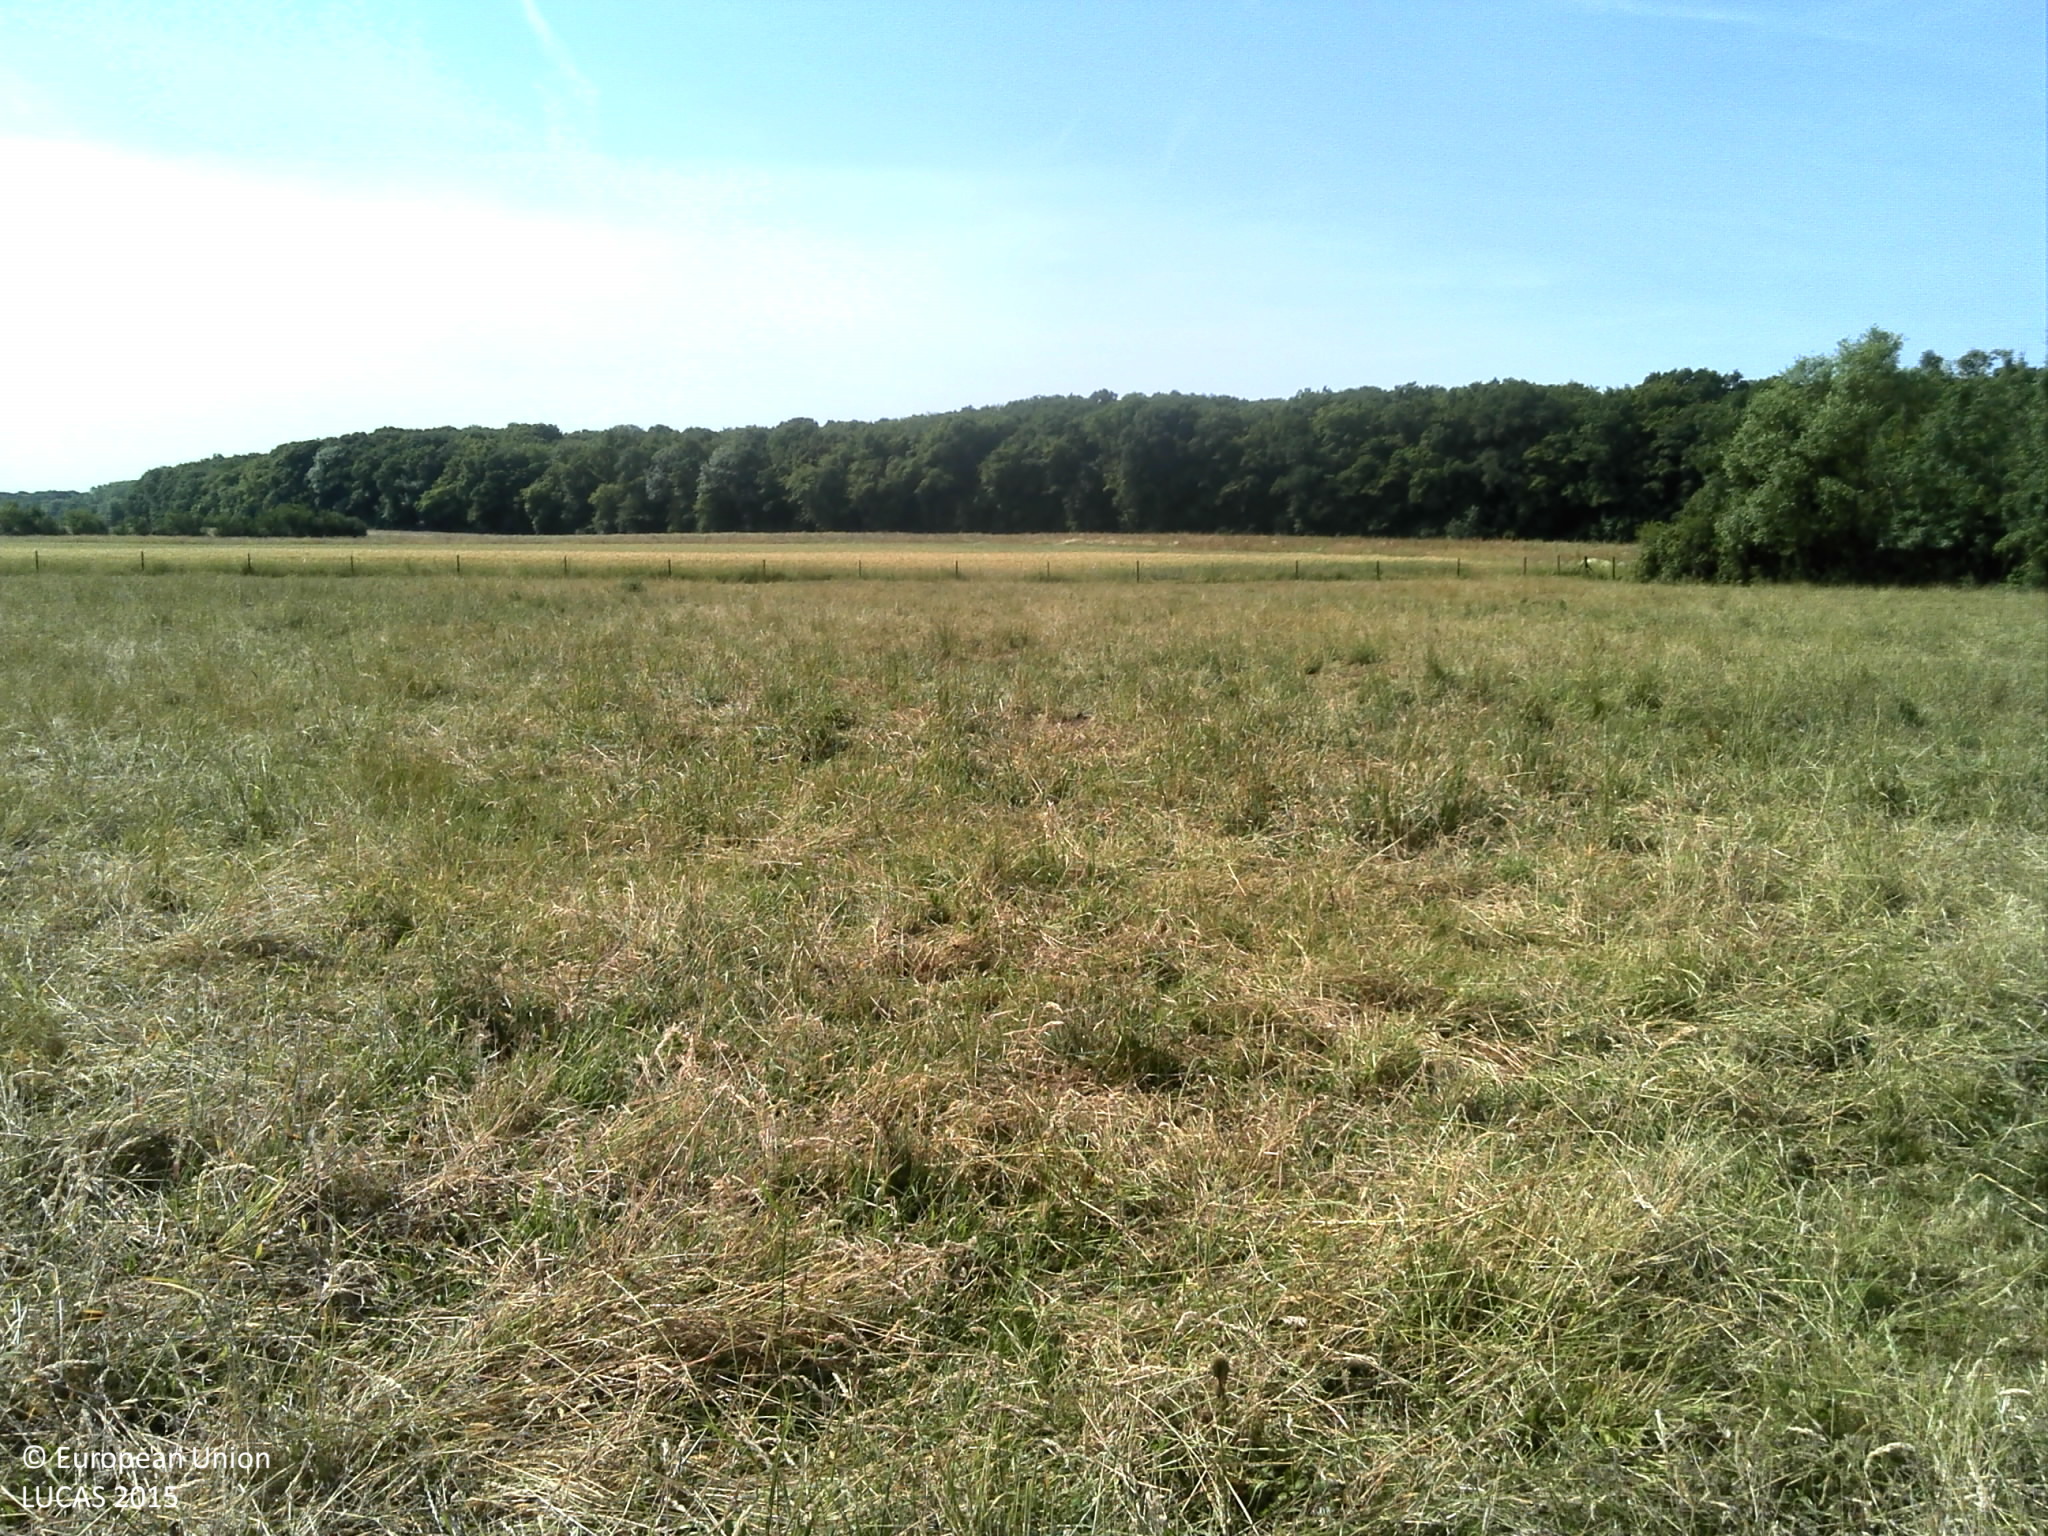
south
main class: Grassland
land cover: Grassland without tree/shrub cover
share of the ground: > 75 %
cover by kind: herbaceous plants 100 %
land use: Agriculture (excluding fallow land and kitchen gardens)
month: June
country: FR
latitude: 49.3473
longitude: 6.2142
